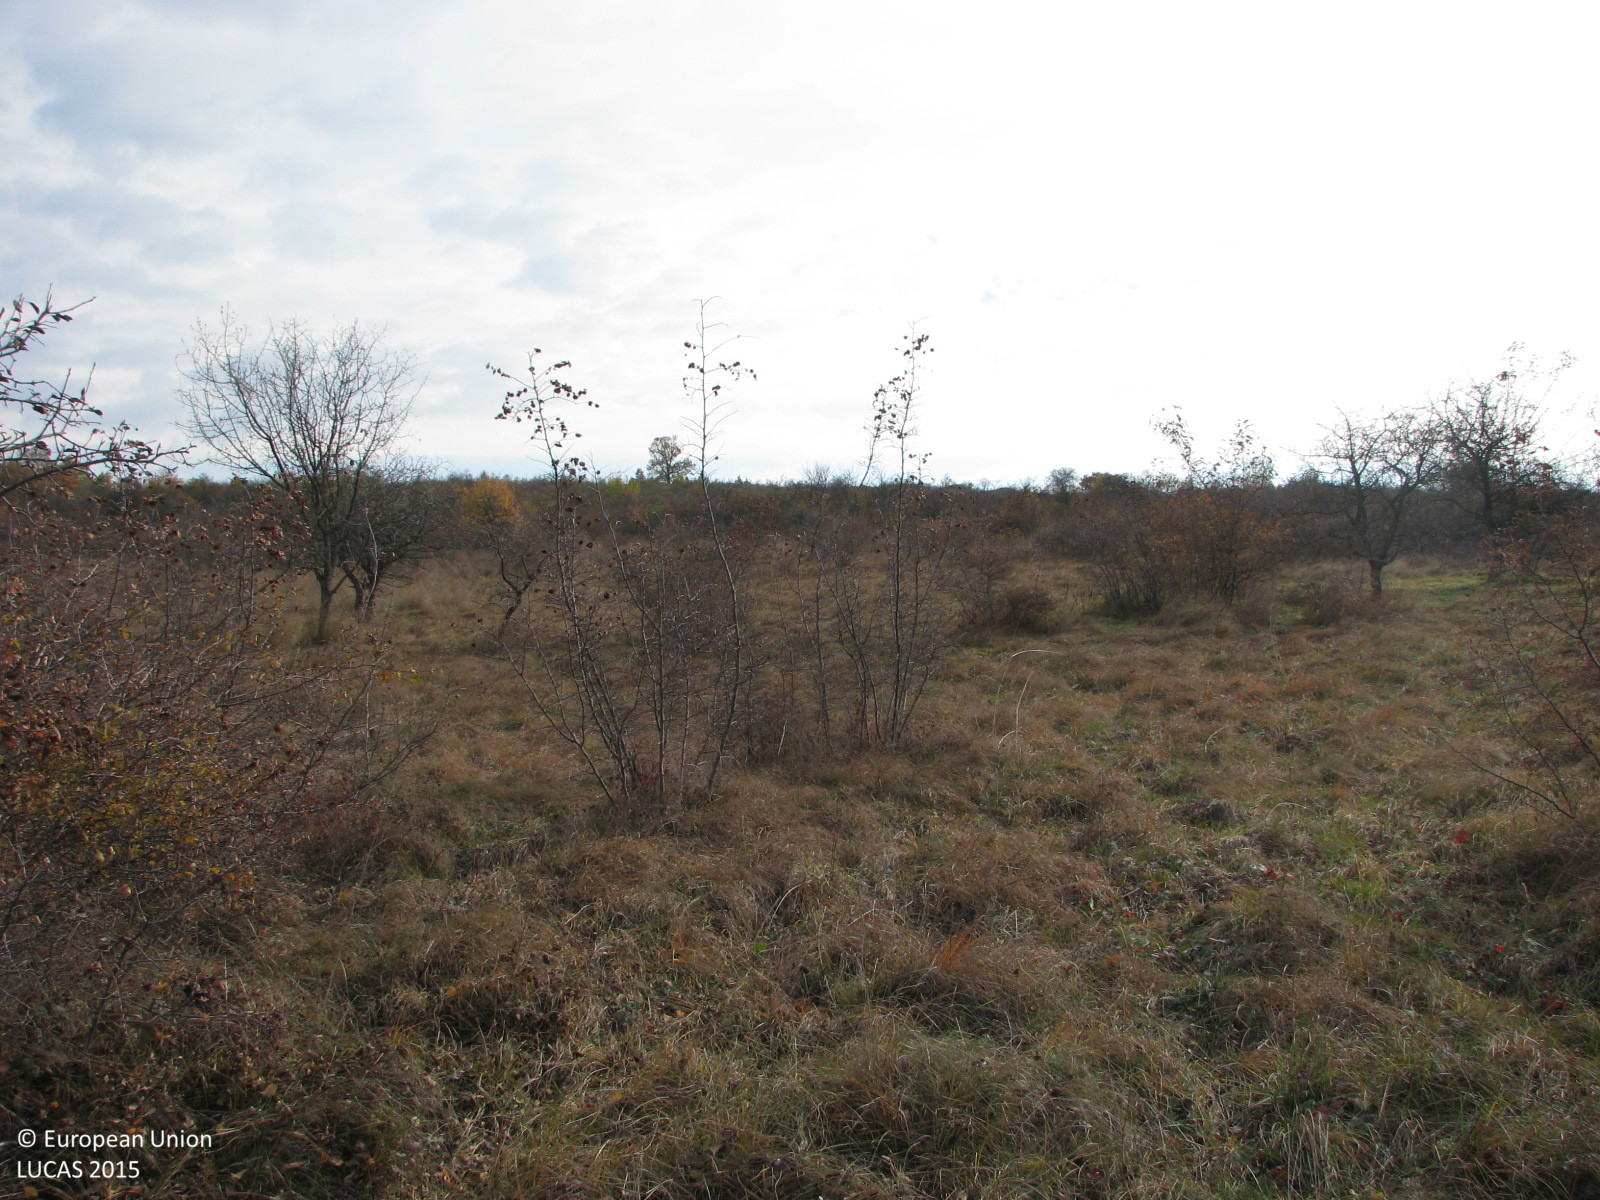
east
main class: Grassland
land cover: Grassland with sparse tree/shrub cover
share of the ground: > 75 %
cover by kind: herbaceous plants 85 %, shrubs 10 %, broadleaved forest trees 5 %
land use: Agriculture (excluding fallow land and kitchen gardens)
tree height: < 5 m
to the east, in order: Grassland with sparse tree/shrub cover; Shrubland with sparse tree cover; Grassland with sparse tree/shrub cover; Rocks and stones; Grassland with sparse tree/shrub cover; Shrubland with sparse tree cover; Grassland with sparse tree/shrub cover
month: November
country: BG
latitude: 41.9417
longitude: 26.4516
